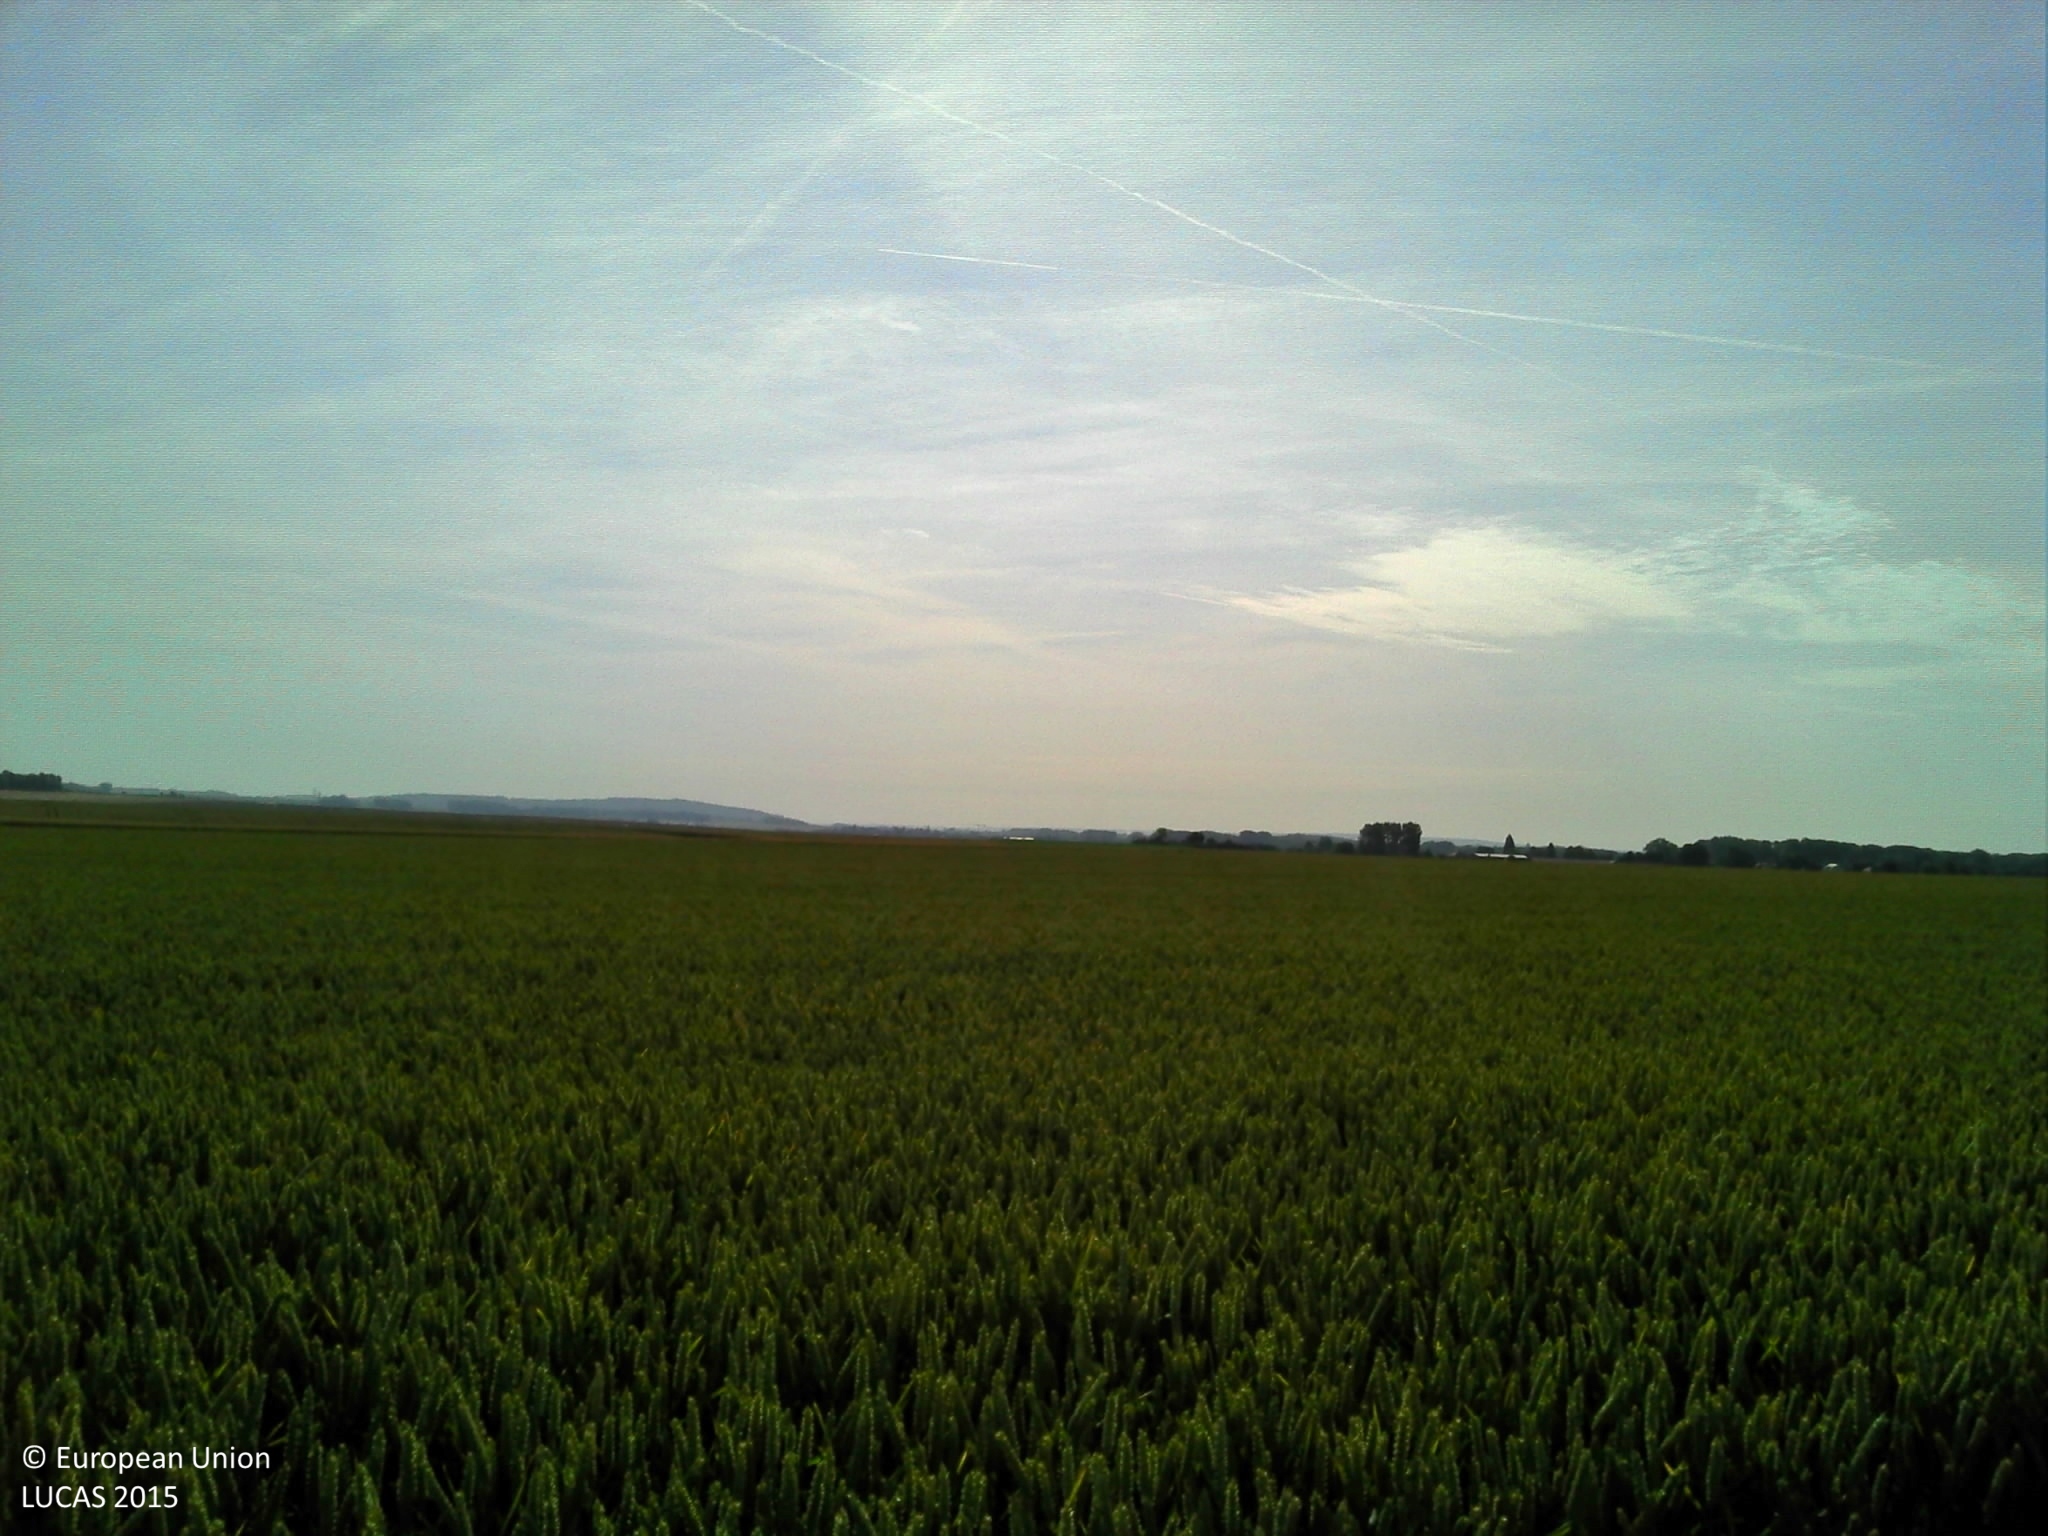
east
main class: Cropland
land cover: Common wheat
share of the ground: > 75 %
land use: Agriculture (excluding fallow land and kitchen gardens)
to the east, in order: Common wheat; Grass margins; Other bare soil; Grass margins; Common wheat
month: June
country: FR
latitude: 49.3492
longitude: 2.6242
